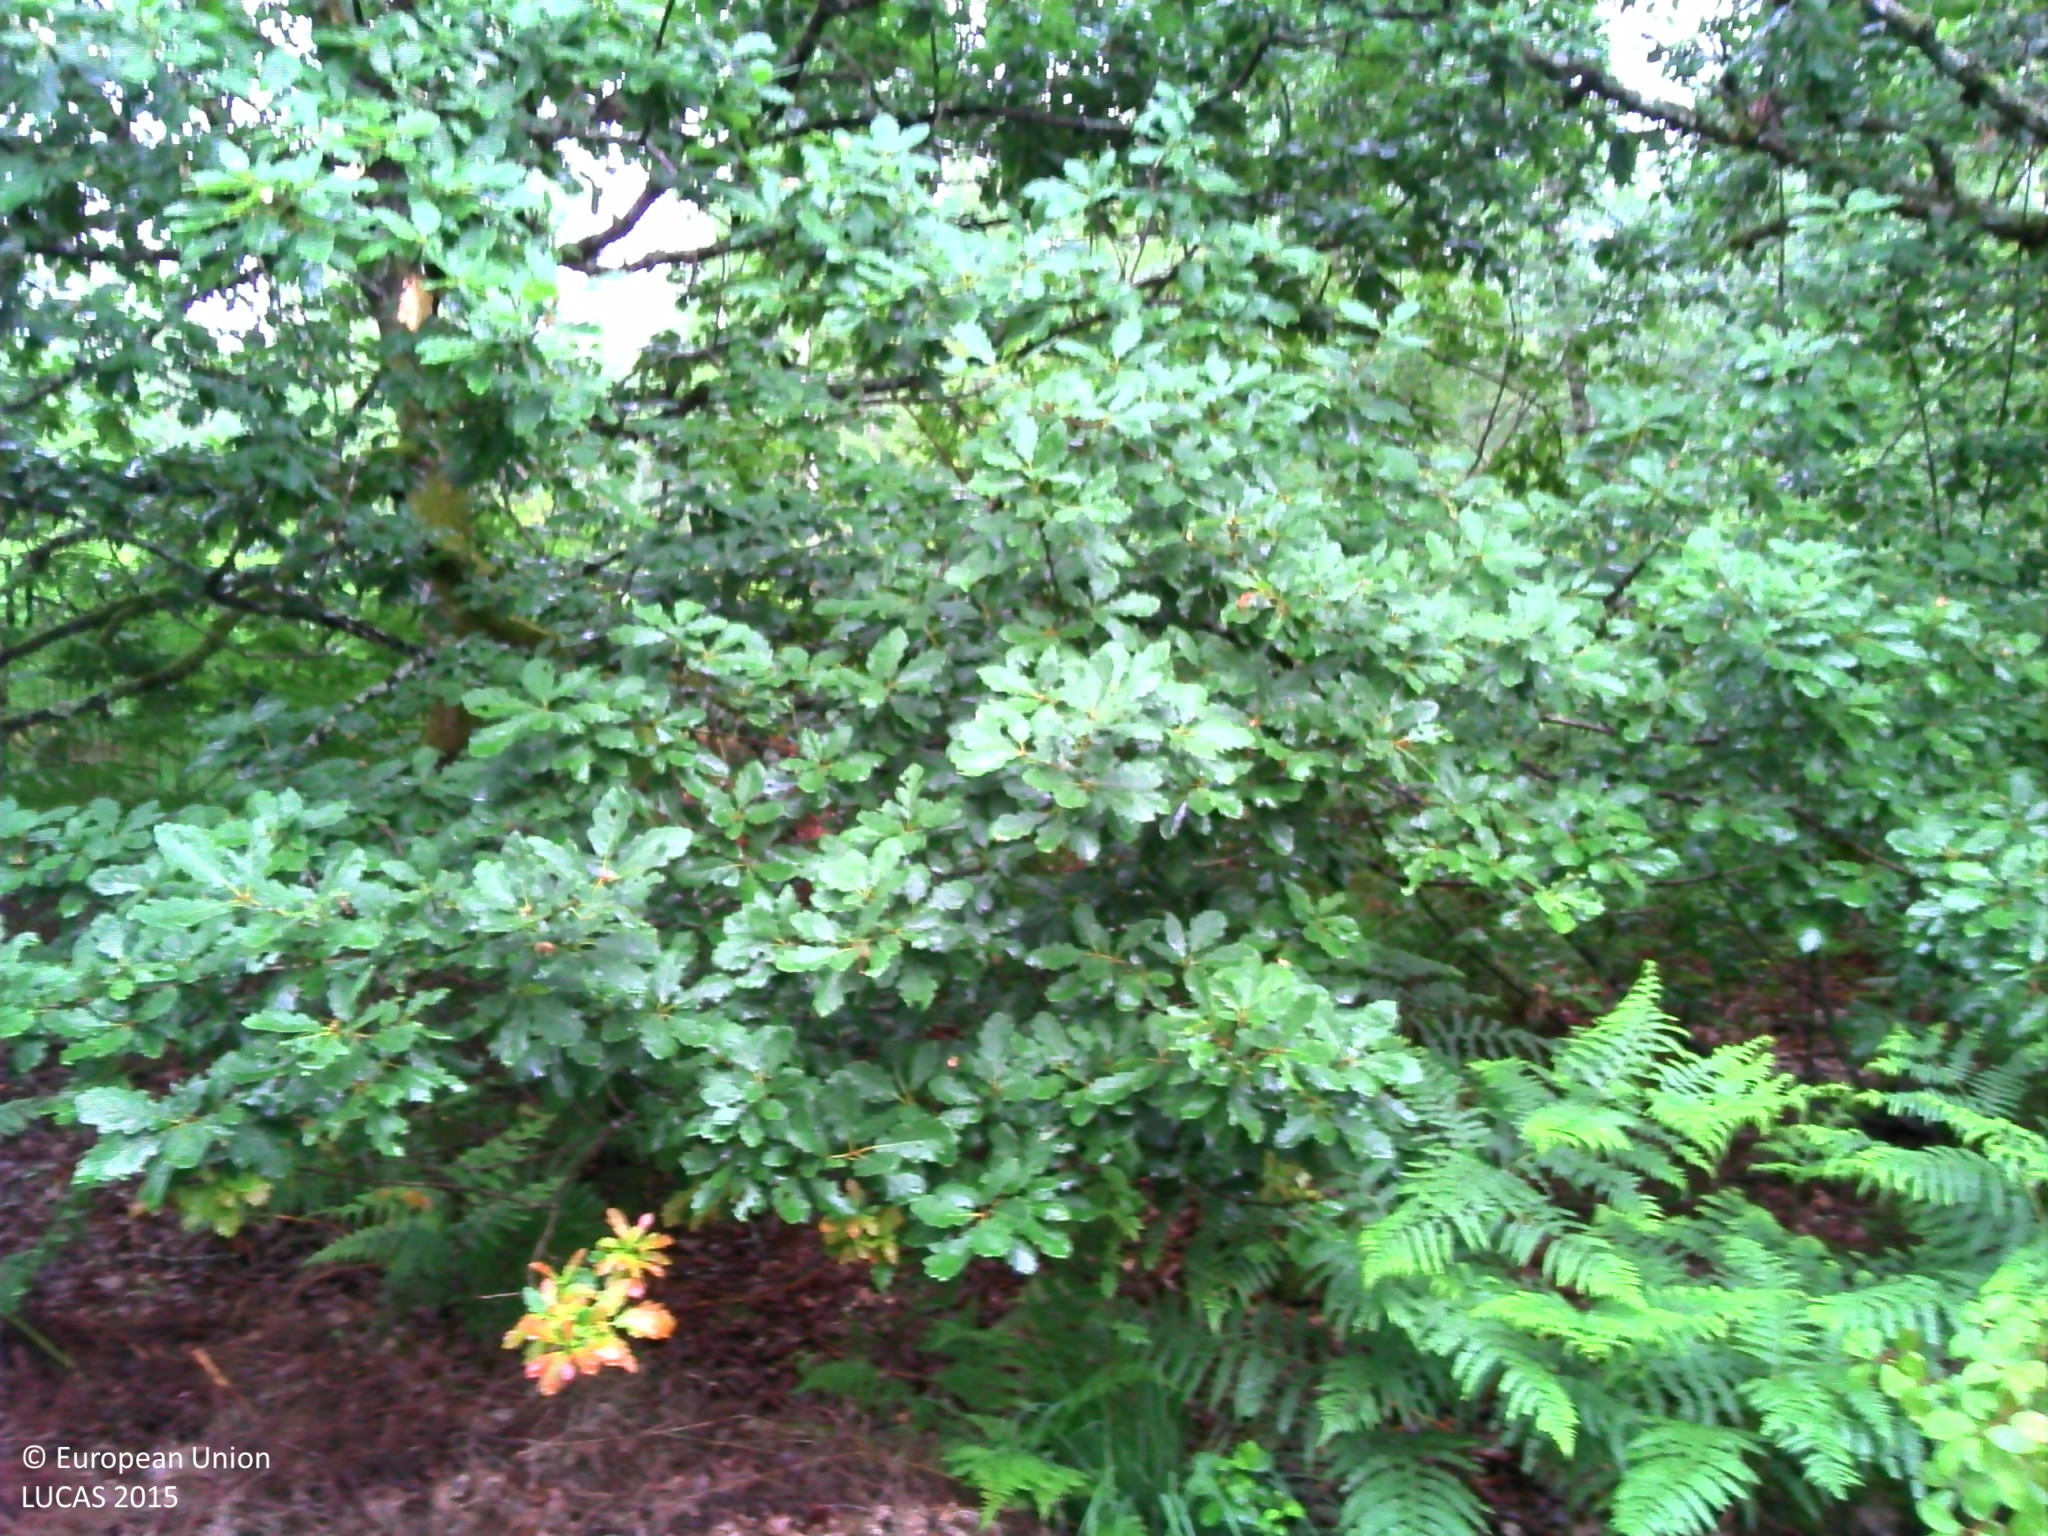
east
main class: Woodland
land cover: Broadleaved woodland
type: acidophilous oak and oak-birch forest
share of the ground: > 75 %
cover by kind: broadleaved forest trees 80 %, unconsolidated bare surface 15 %, herbaceous plants 5 %
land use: Forestry
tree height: > 5 m
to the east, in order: Broadleaved woodland; Spruce dominated mixed woodland; Electric lines; Spruce dominated mixed woodland; Tracks; Spruce dominated mixed woodland
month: June
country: FR
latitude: 47.7928
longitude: 6.5972
